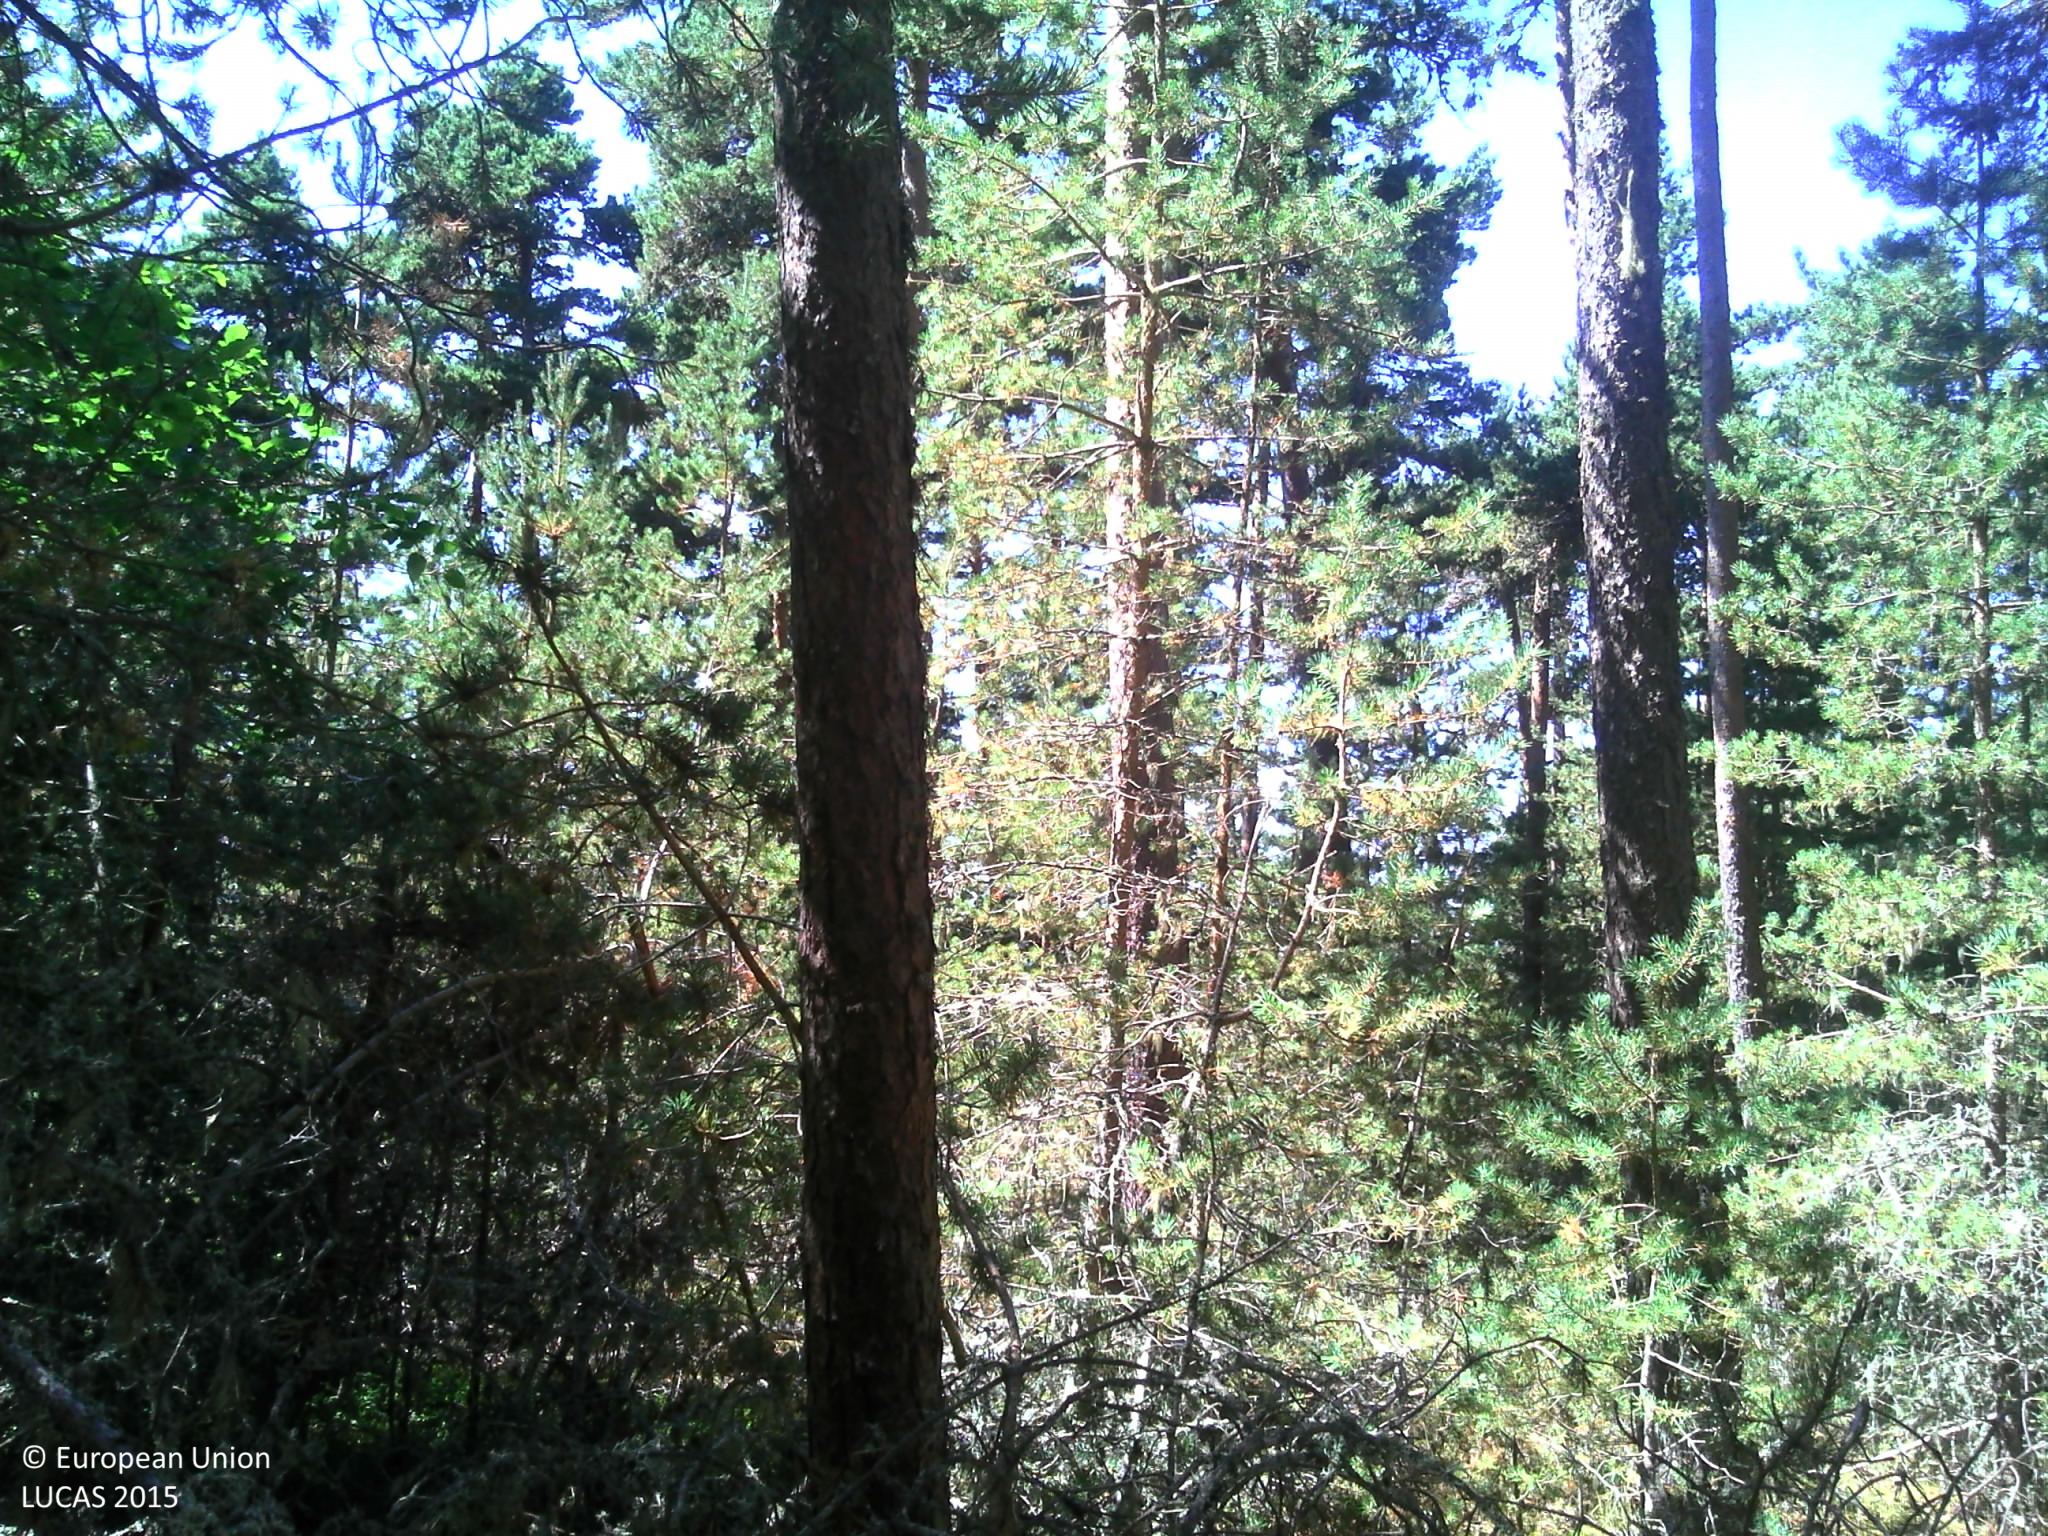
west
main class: Woodland
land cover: Pine dominated coniferous woodland
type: alpine coniferous forest
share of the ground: > 75 %
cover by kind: coniferous forest trees 75 %, herbaceous plants 20 %, broadleaved forest trees 5 %
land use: Forestry
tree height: > 5 m
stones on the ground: > 50 %
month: August
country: FR
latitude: 44.5835
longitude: 3.5438
